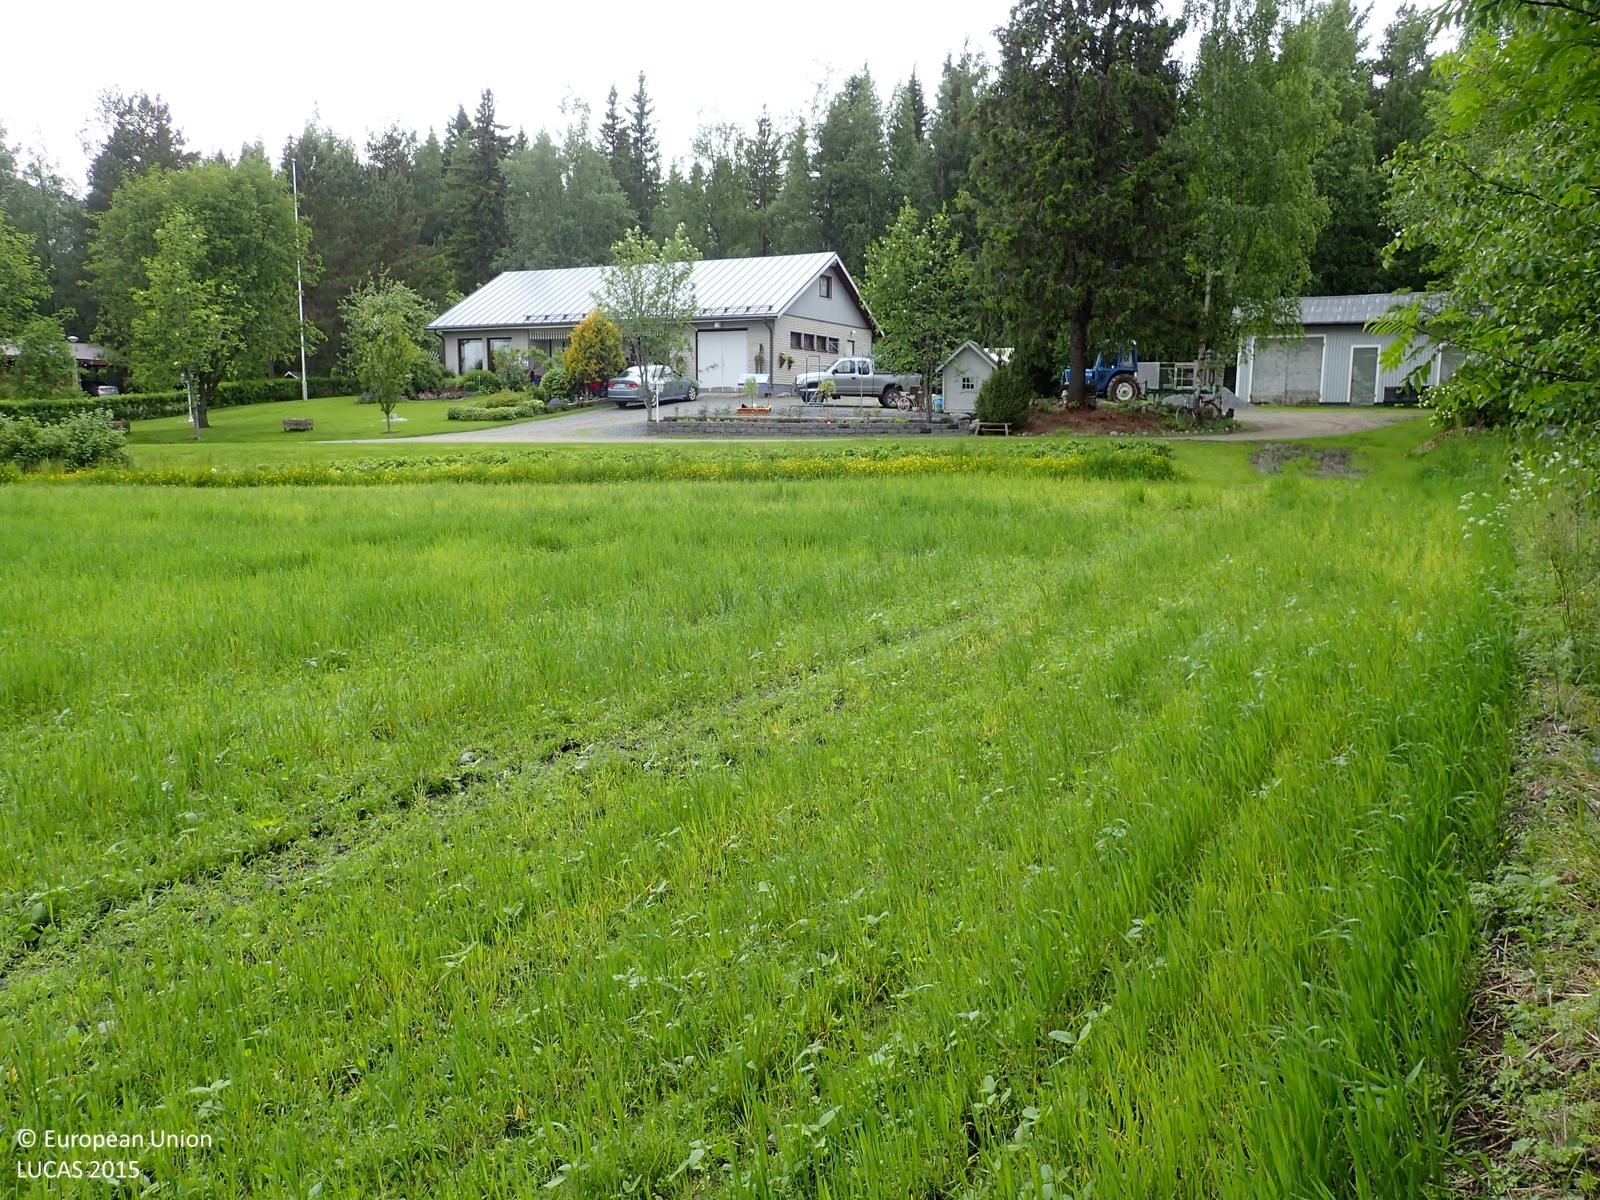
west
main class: Cropland
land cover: Barley
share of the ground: > 75 %
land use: Agriculture (excluding fallow land and kitchen gardens)
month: June
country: FI
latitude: 62.3174
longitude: 21.7205
